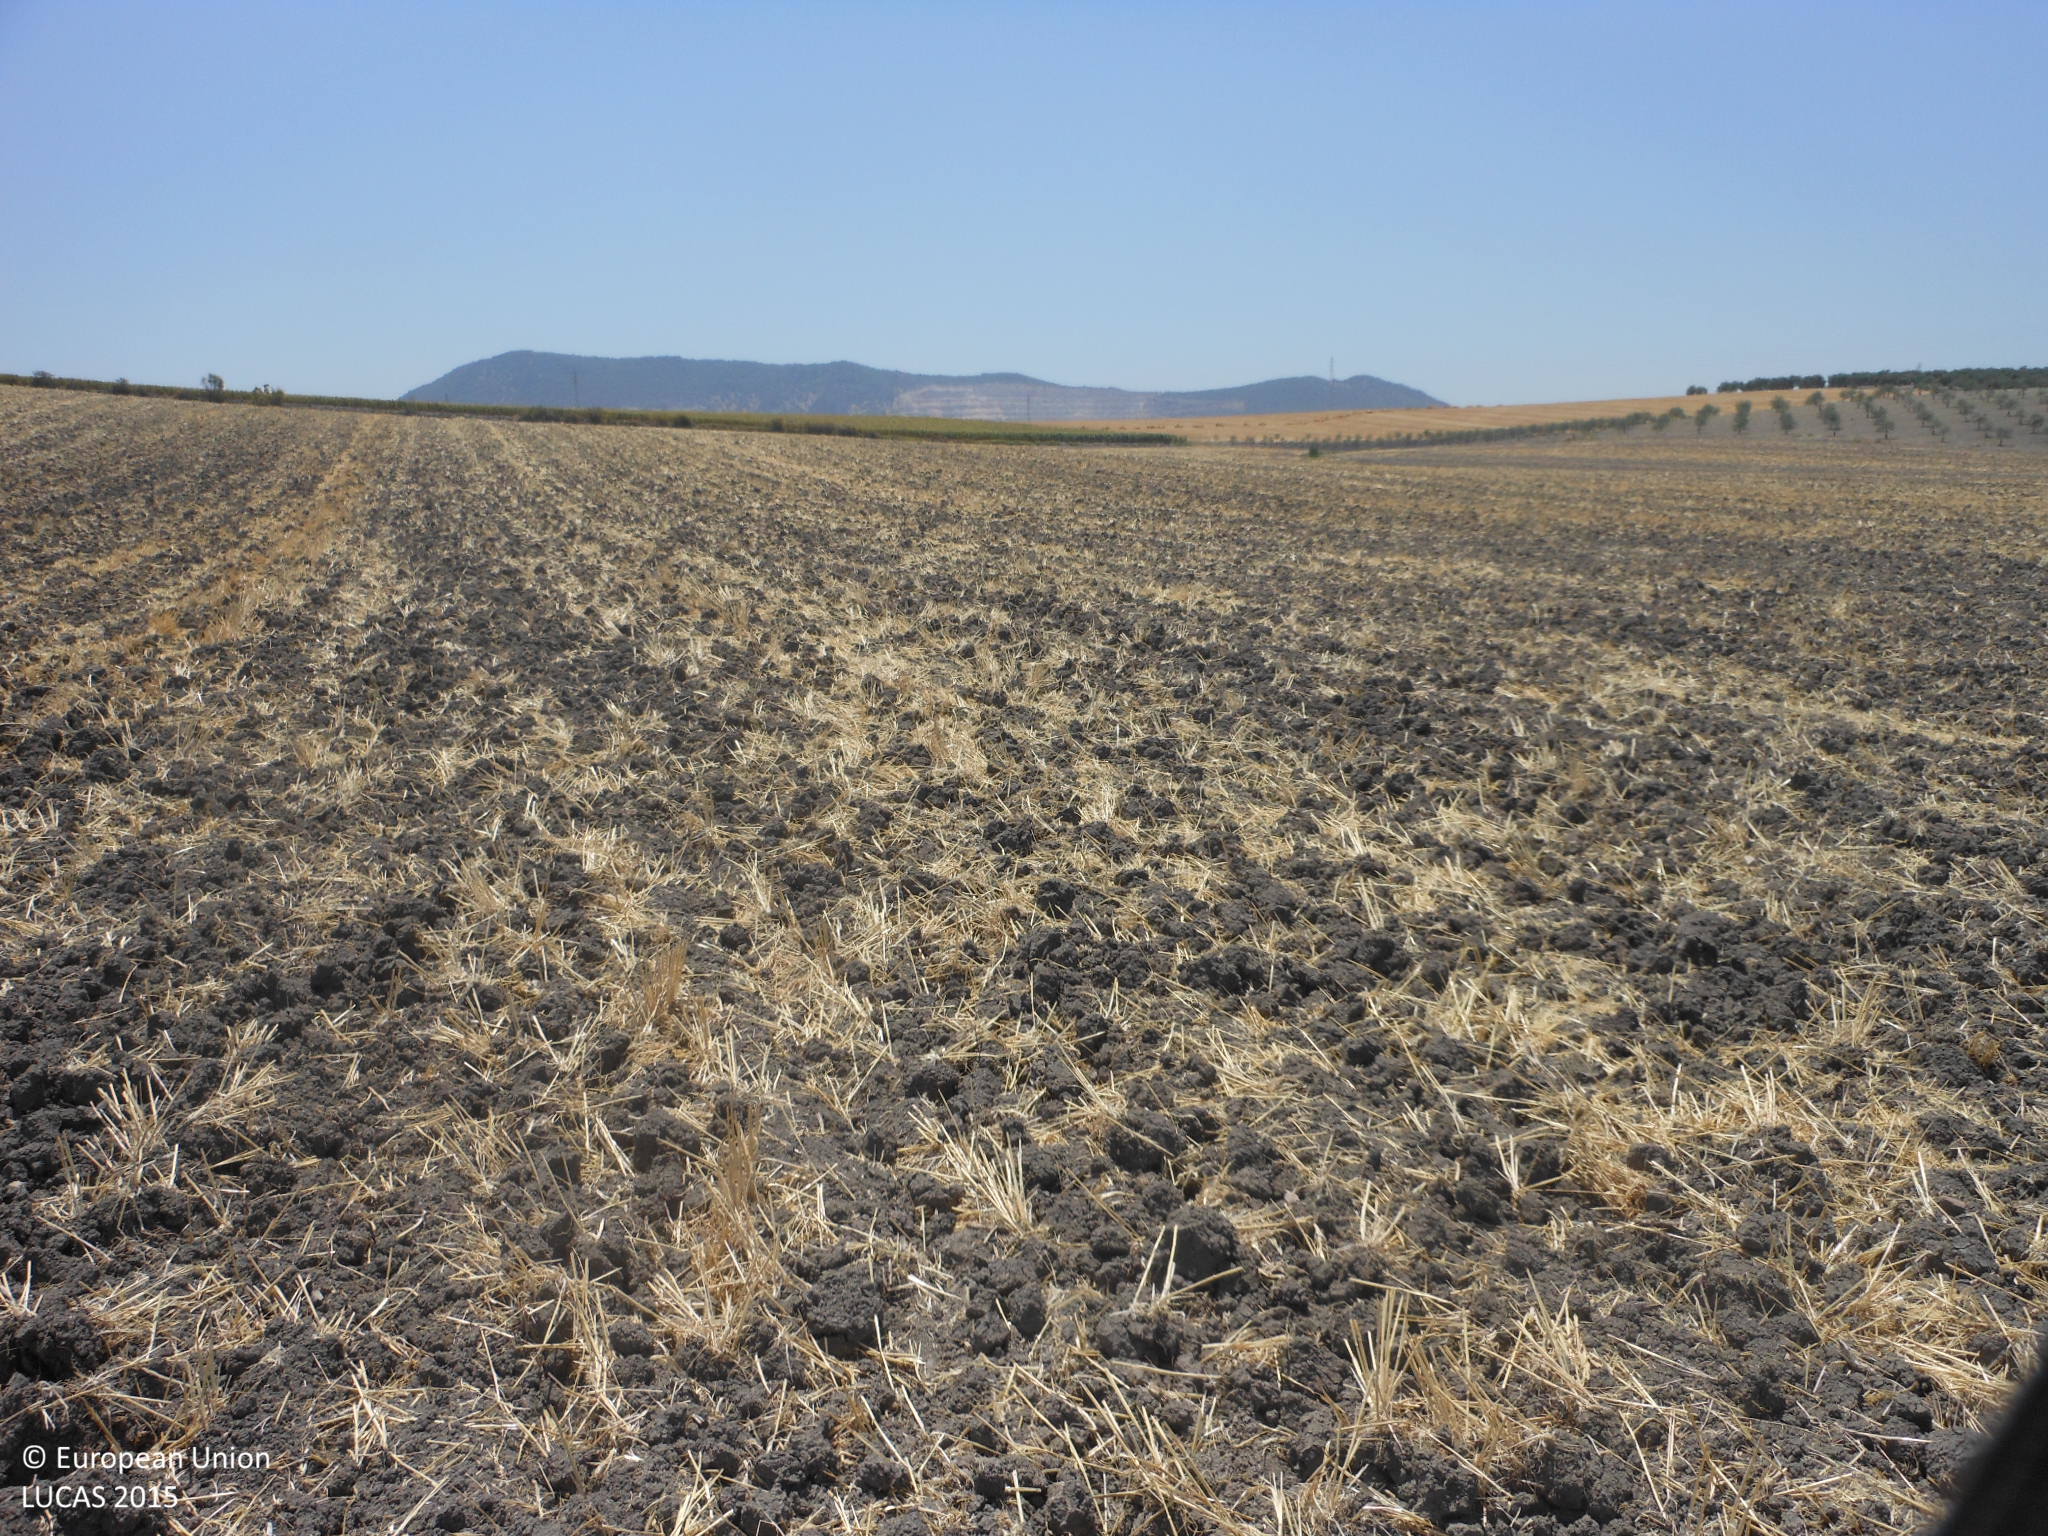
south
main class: Cropland
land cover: Common wheat
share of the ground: < 10 %
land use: Agriculture (excluding fallow land and kitchen gardens)
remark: Harvested field
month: June
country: ES
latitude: 37.1297
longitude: -5.5110
